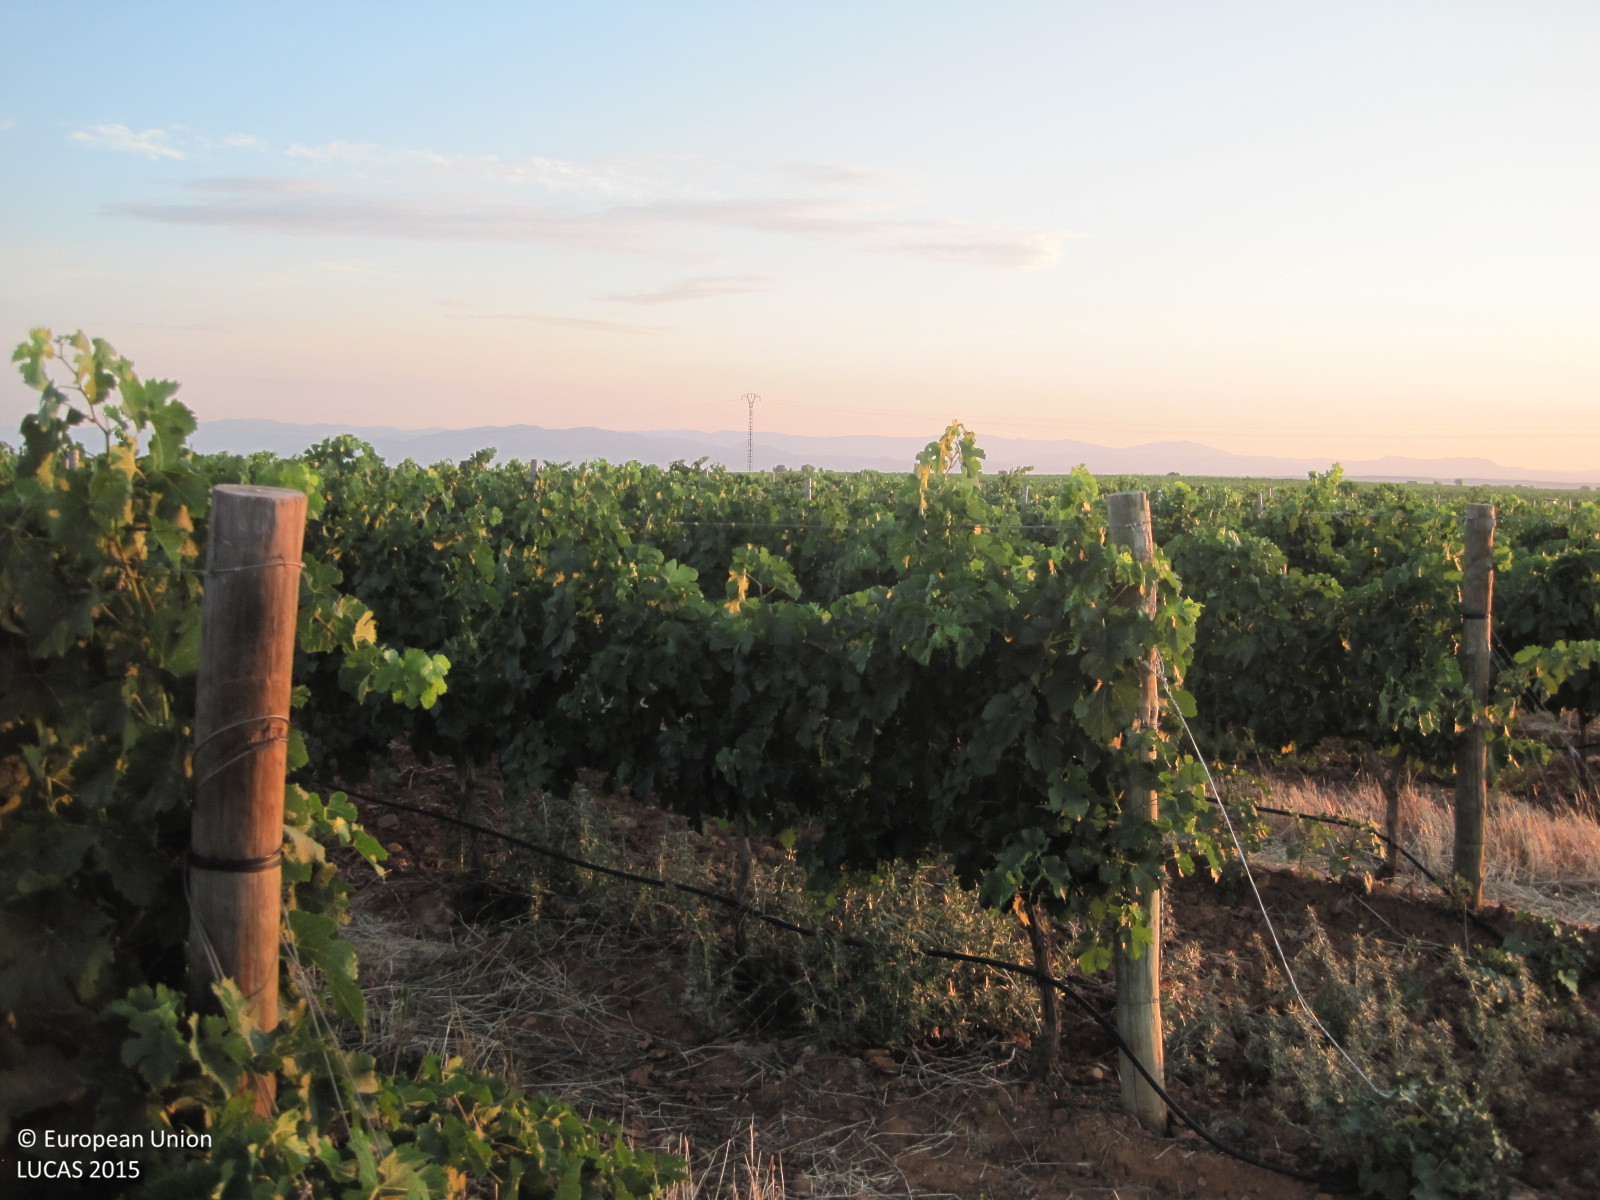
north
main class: Cropland
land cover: Vineyards
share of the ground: > 75 %
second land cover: Other bare soil
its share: > 75 %
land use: Agriculture (excluding fallow land and kitchen gardens)
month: June
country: ES
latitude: 39.8772
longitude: -4.6474
